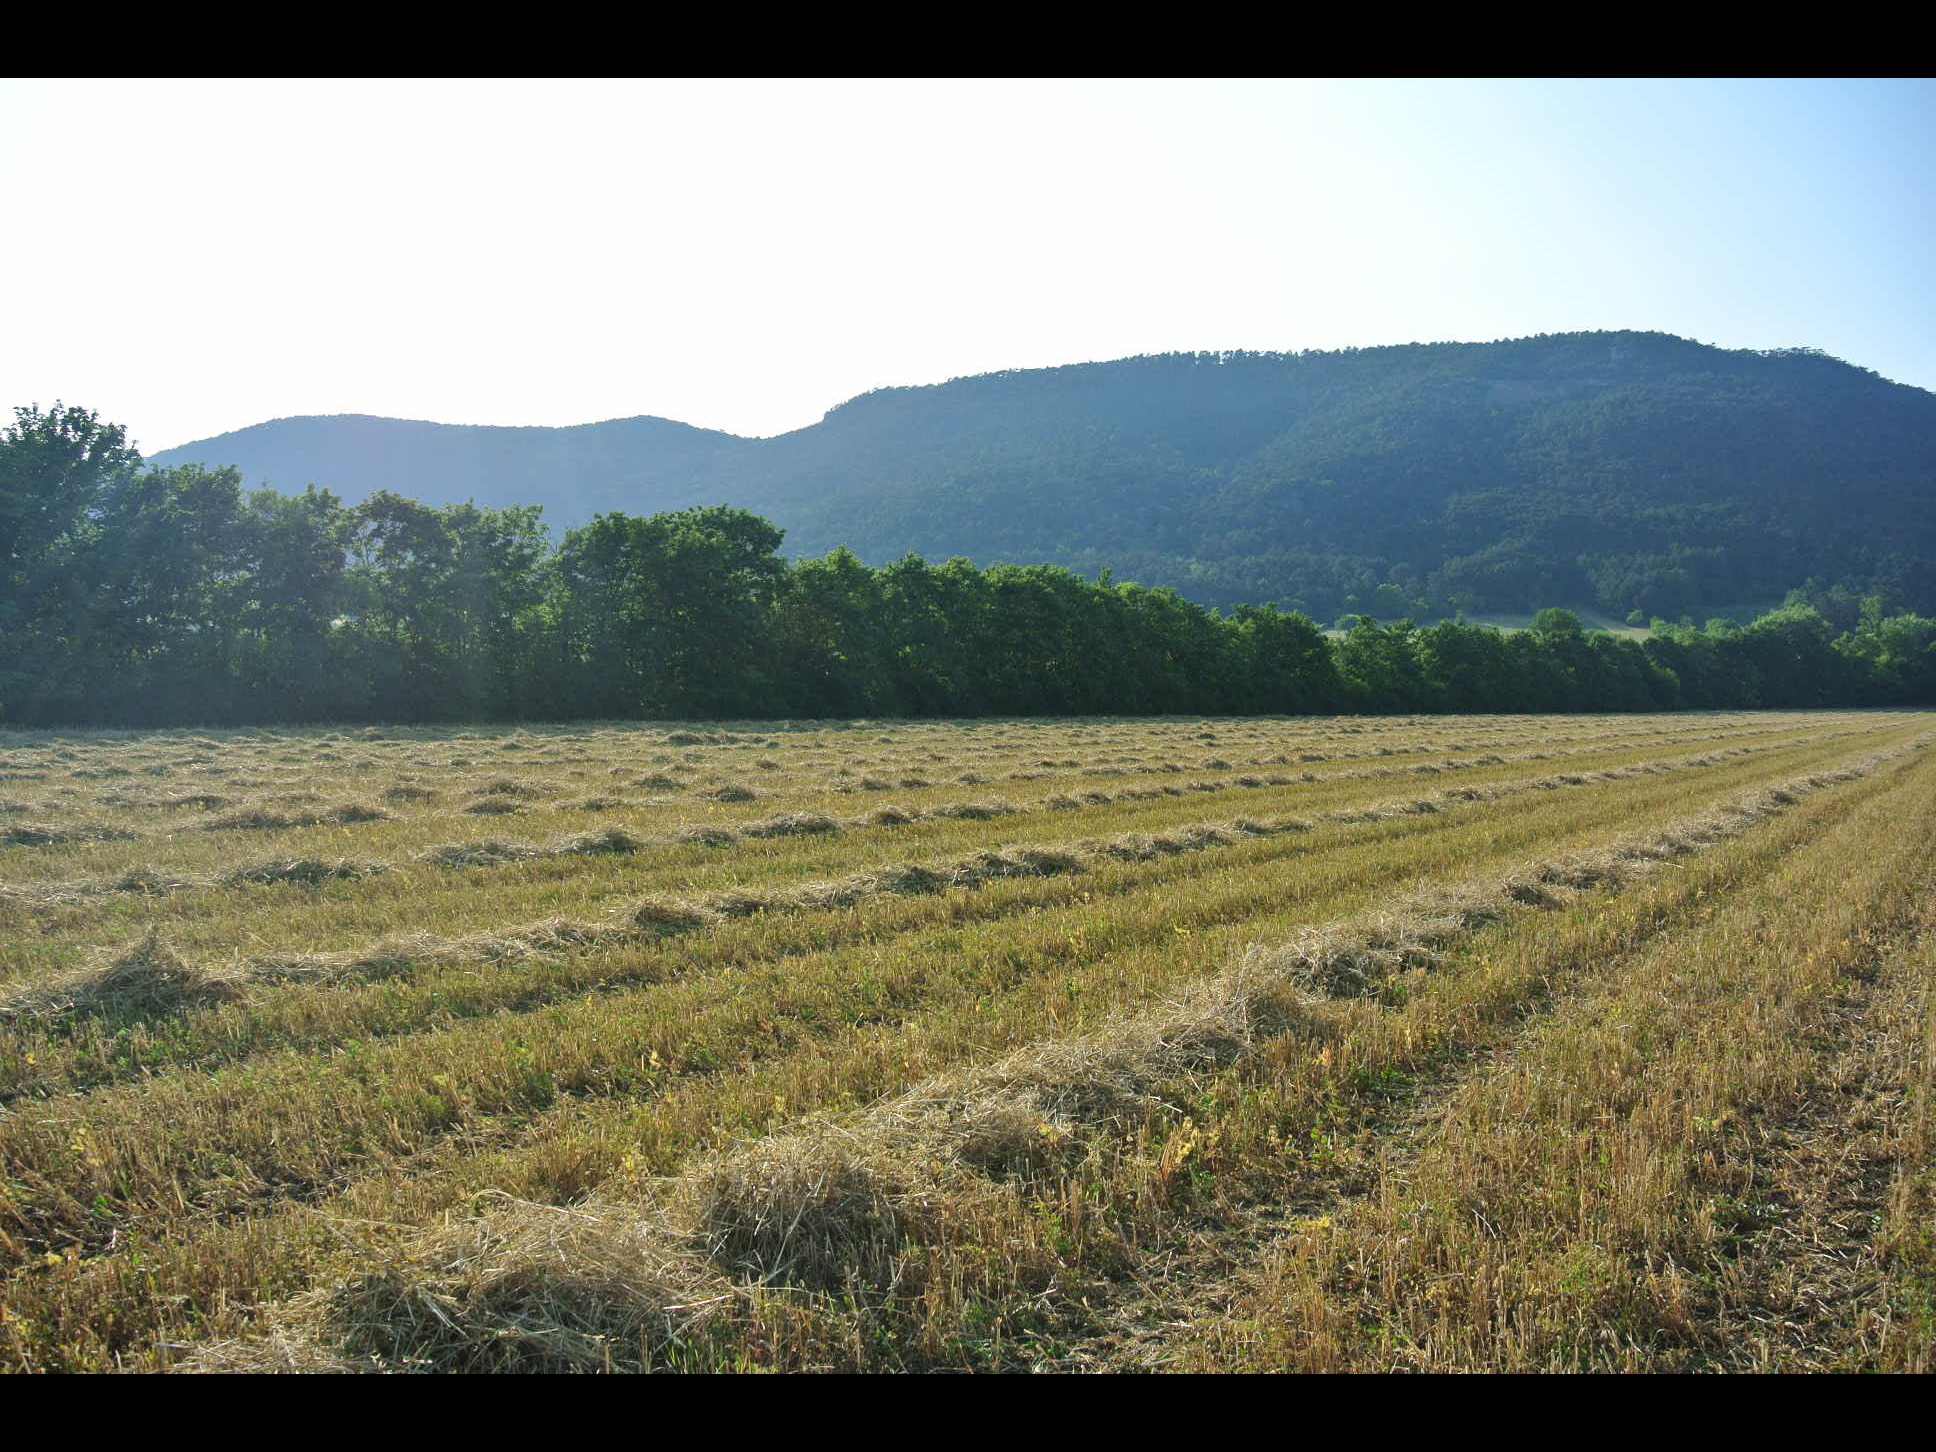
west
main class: Cropland
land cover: Oats
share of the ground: > 75 %
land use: Agriculture (excluding fallow land and kitchen gardens)
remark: Harvested field
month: July
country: AT
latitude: 47.8181
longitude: 16.1337
